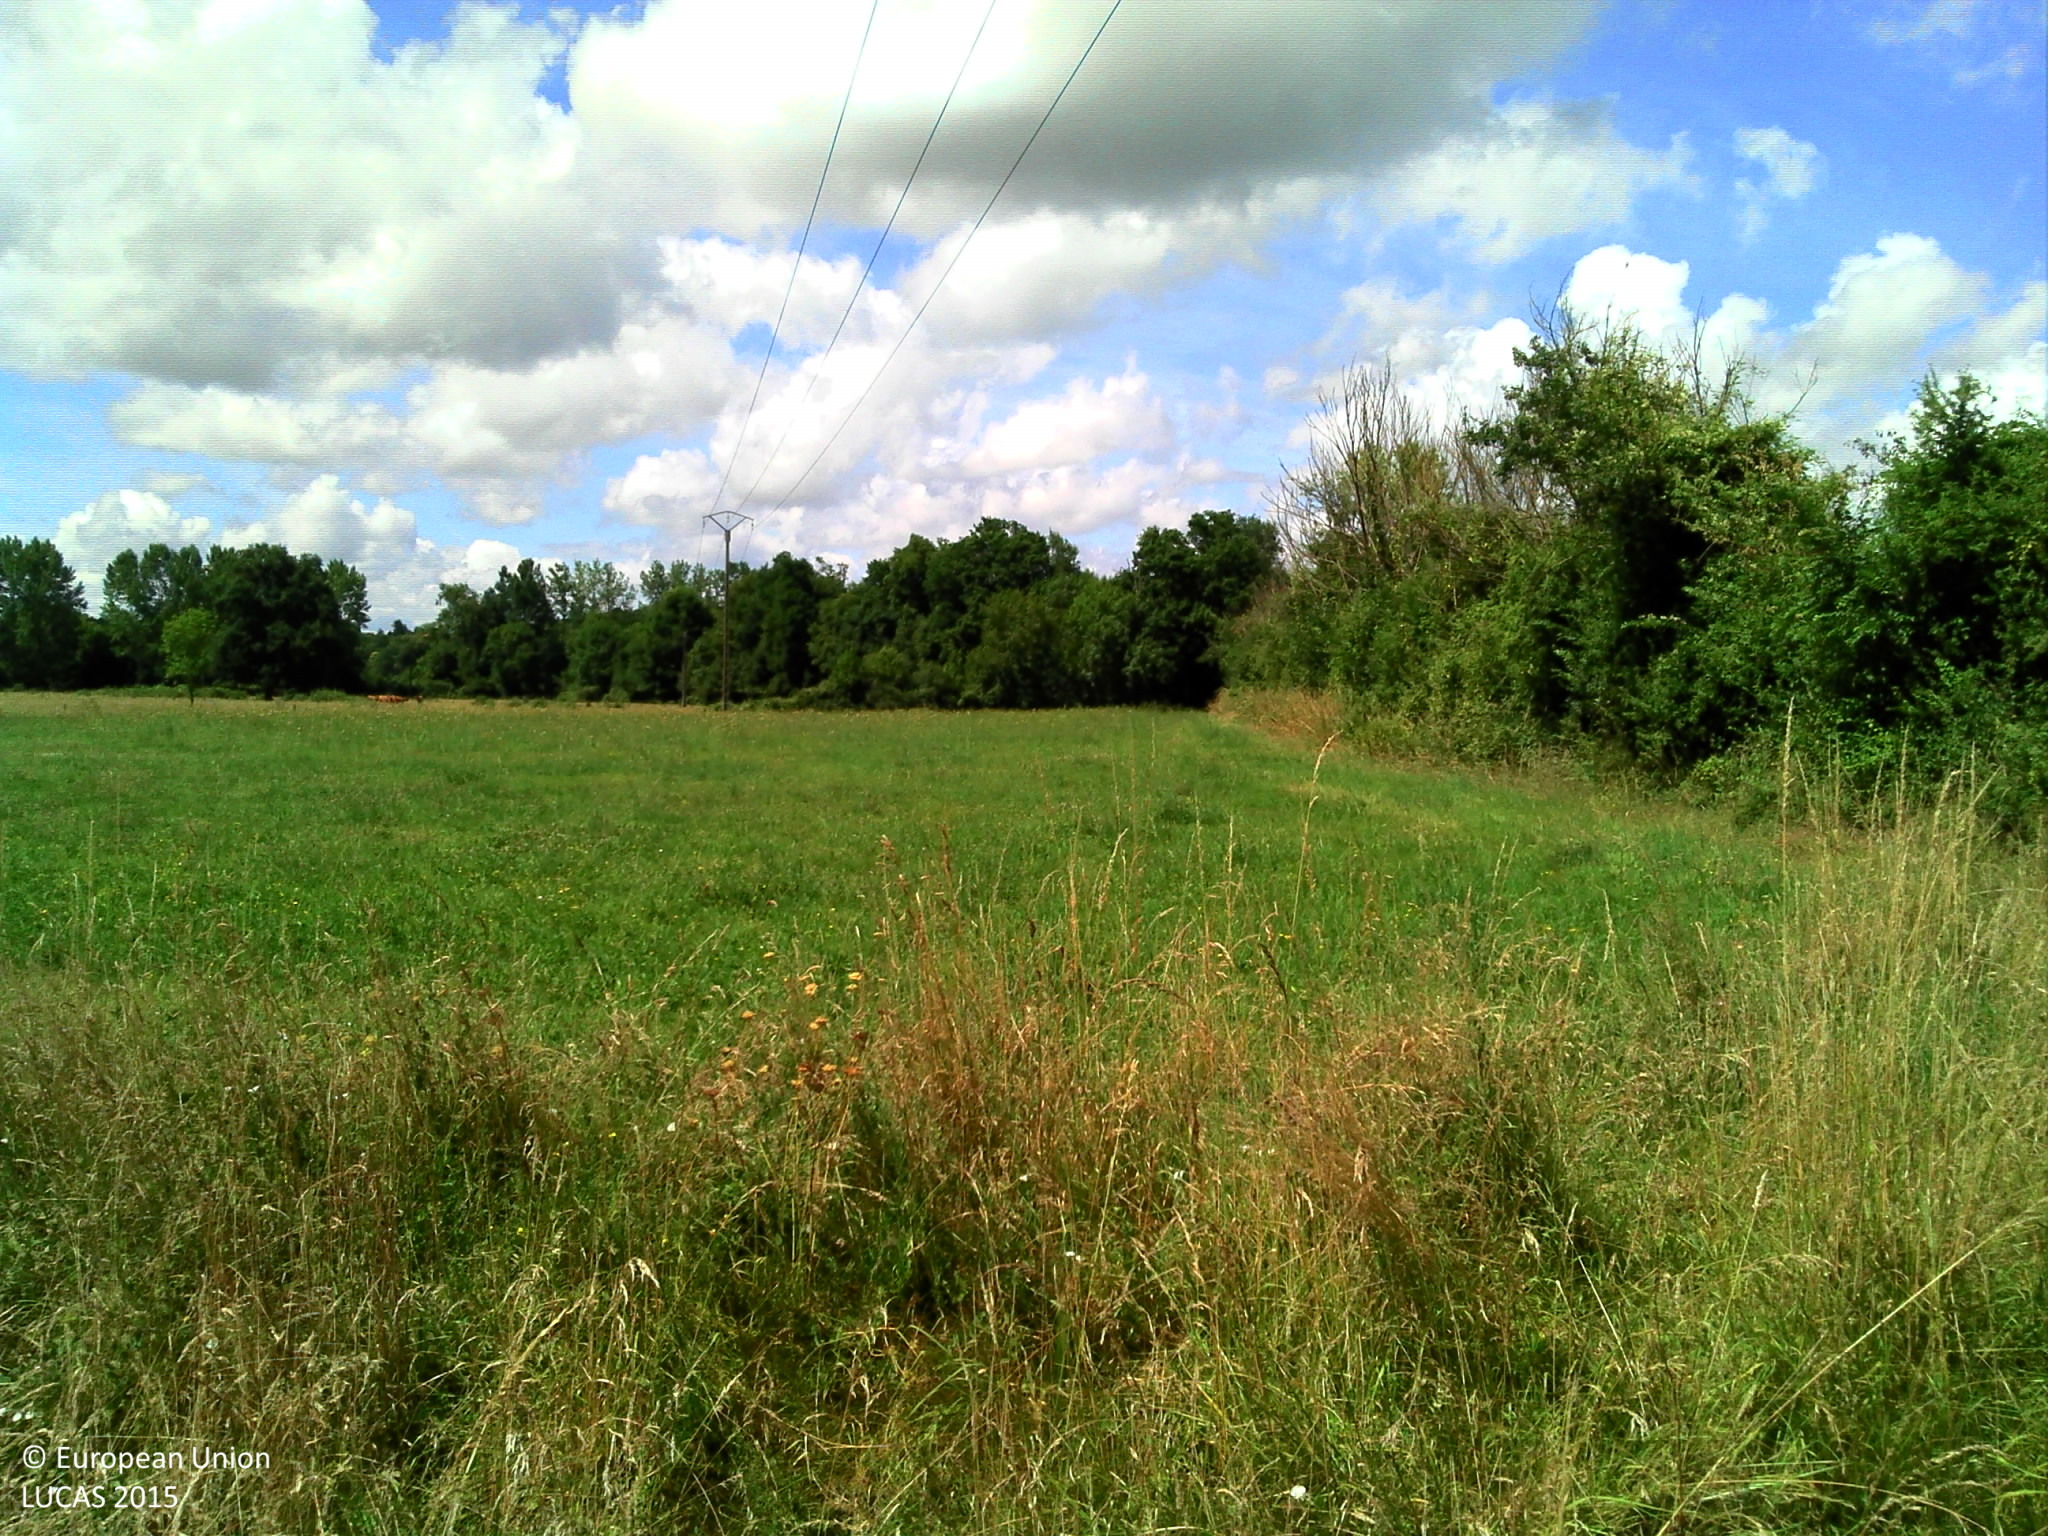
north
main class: Grassland
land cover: Grassland without tree/shrub cover
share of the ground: > 75 %
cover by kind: herbaceous plants 100 %
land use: Agriculture (excluding fallow land and kitchen gardens)
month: June
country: FR
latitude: 45.6690
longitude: 0.4486
